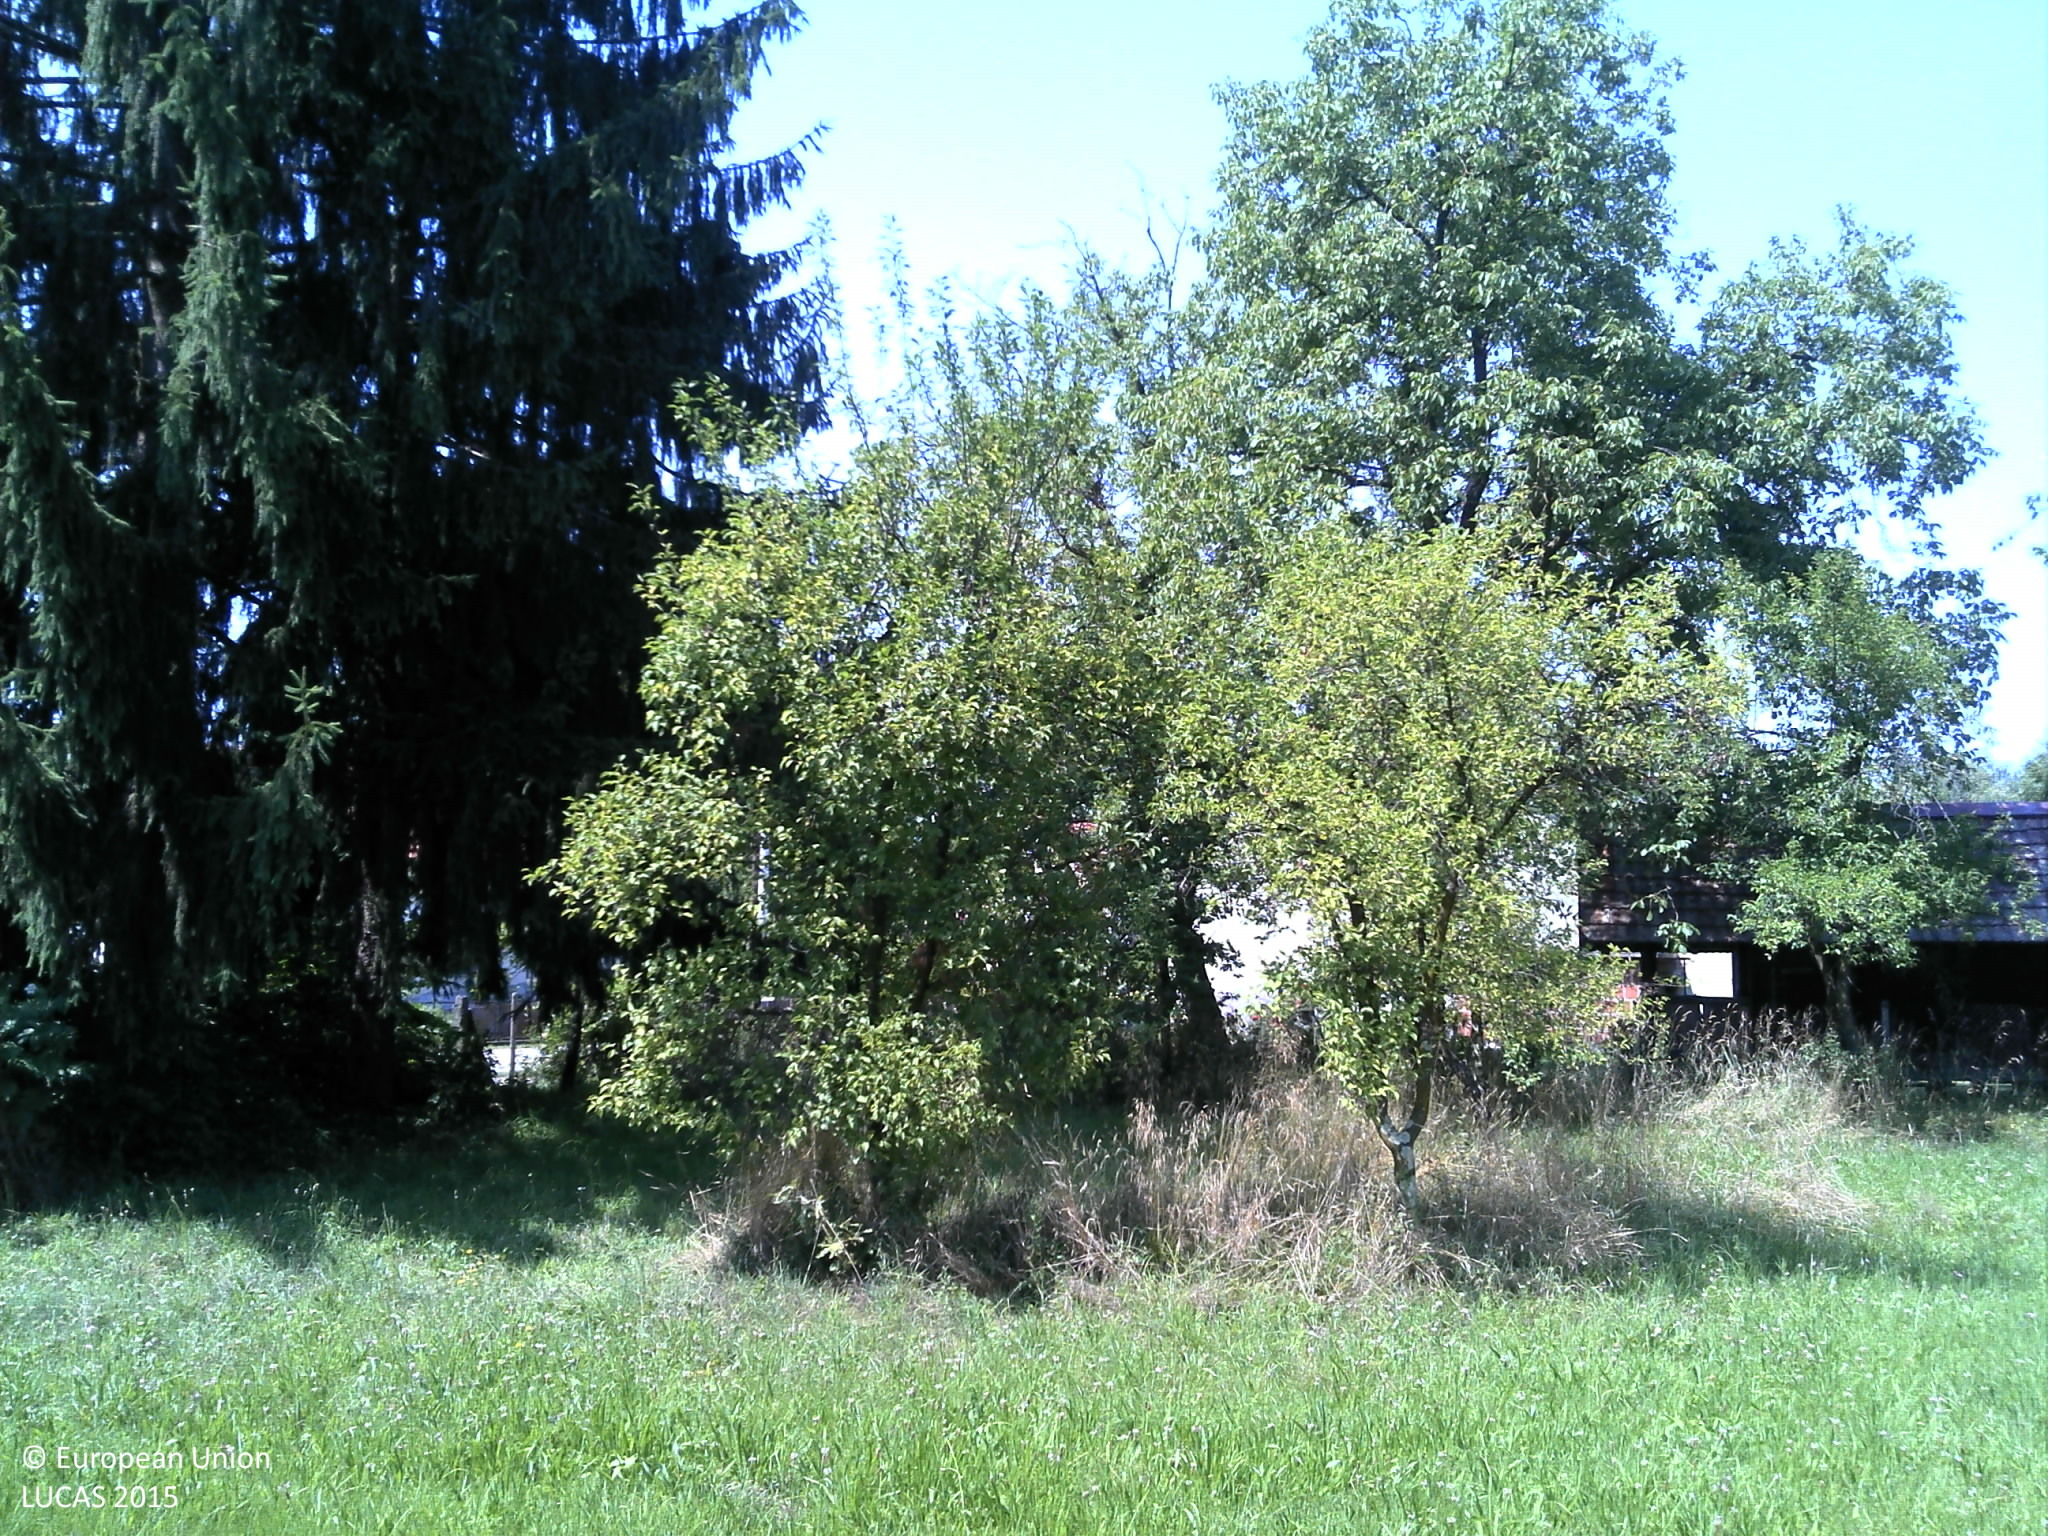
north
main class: Grassland
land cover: Grassland without tree/shrub cover
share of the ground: > 75 %
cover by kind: herbaceous plants 100 %
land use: Semi-natural and natural areas not in use
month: July
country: HR
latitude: 45.7649
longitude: 16.6471
